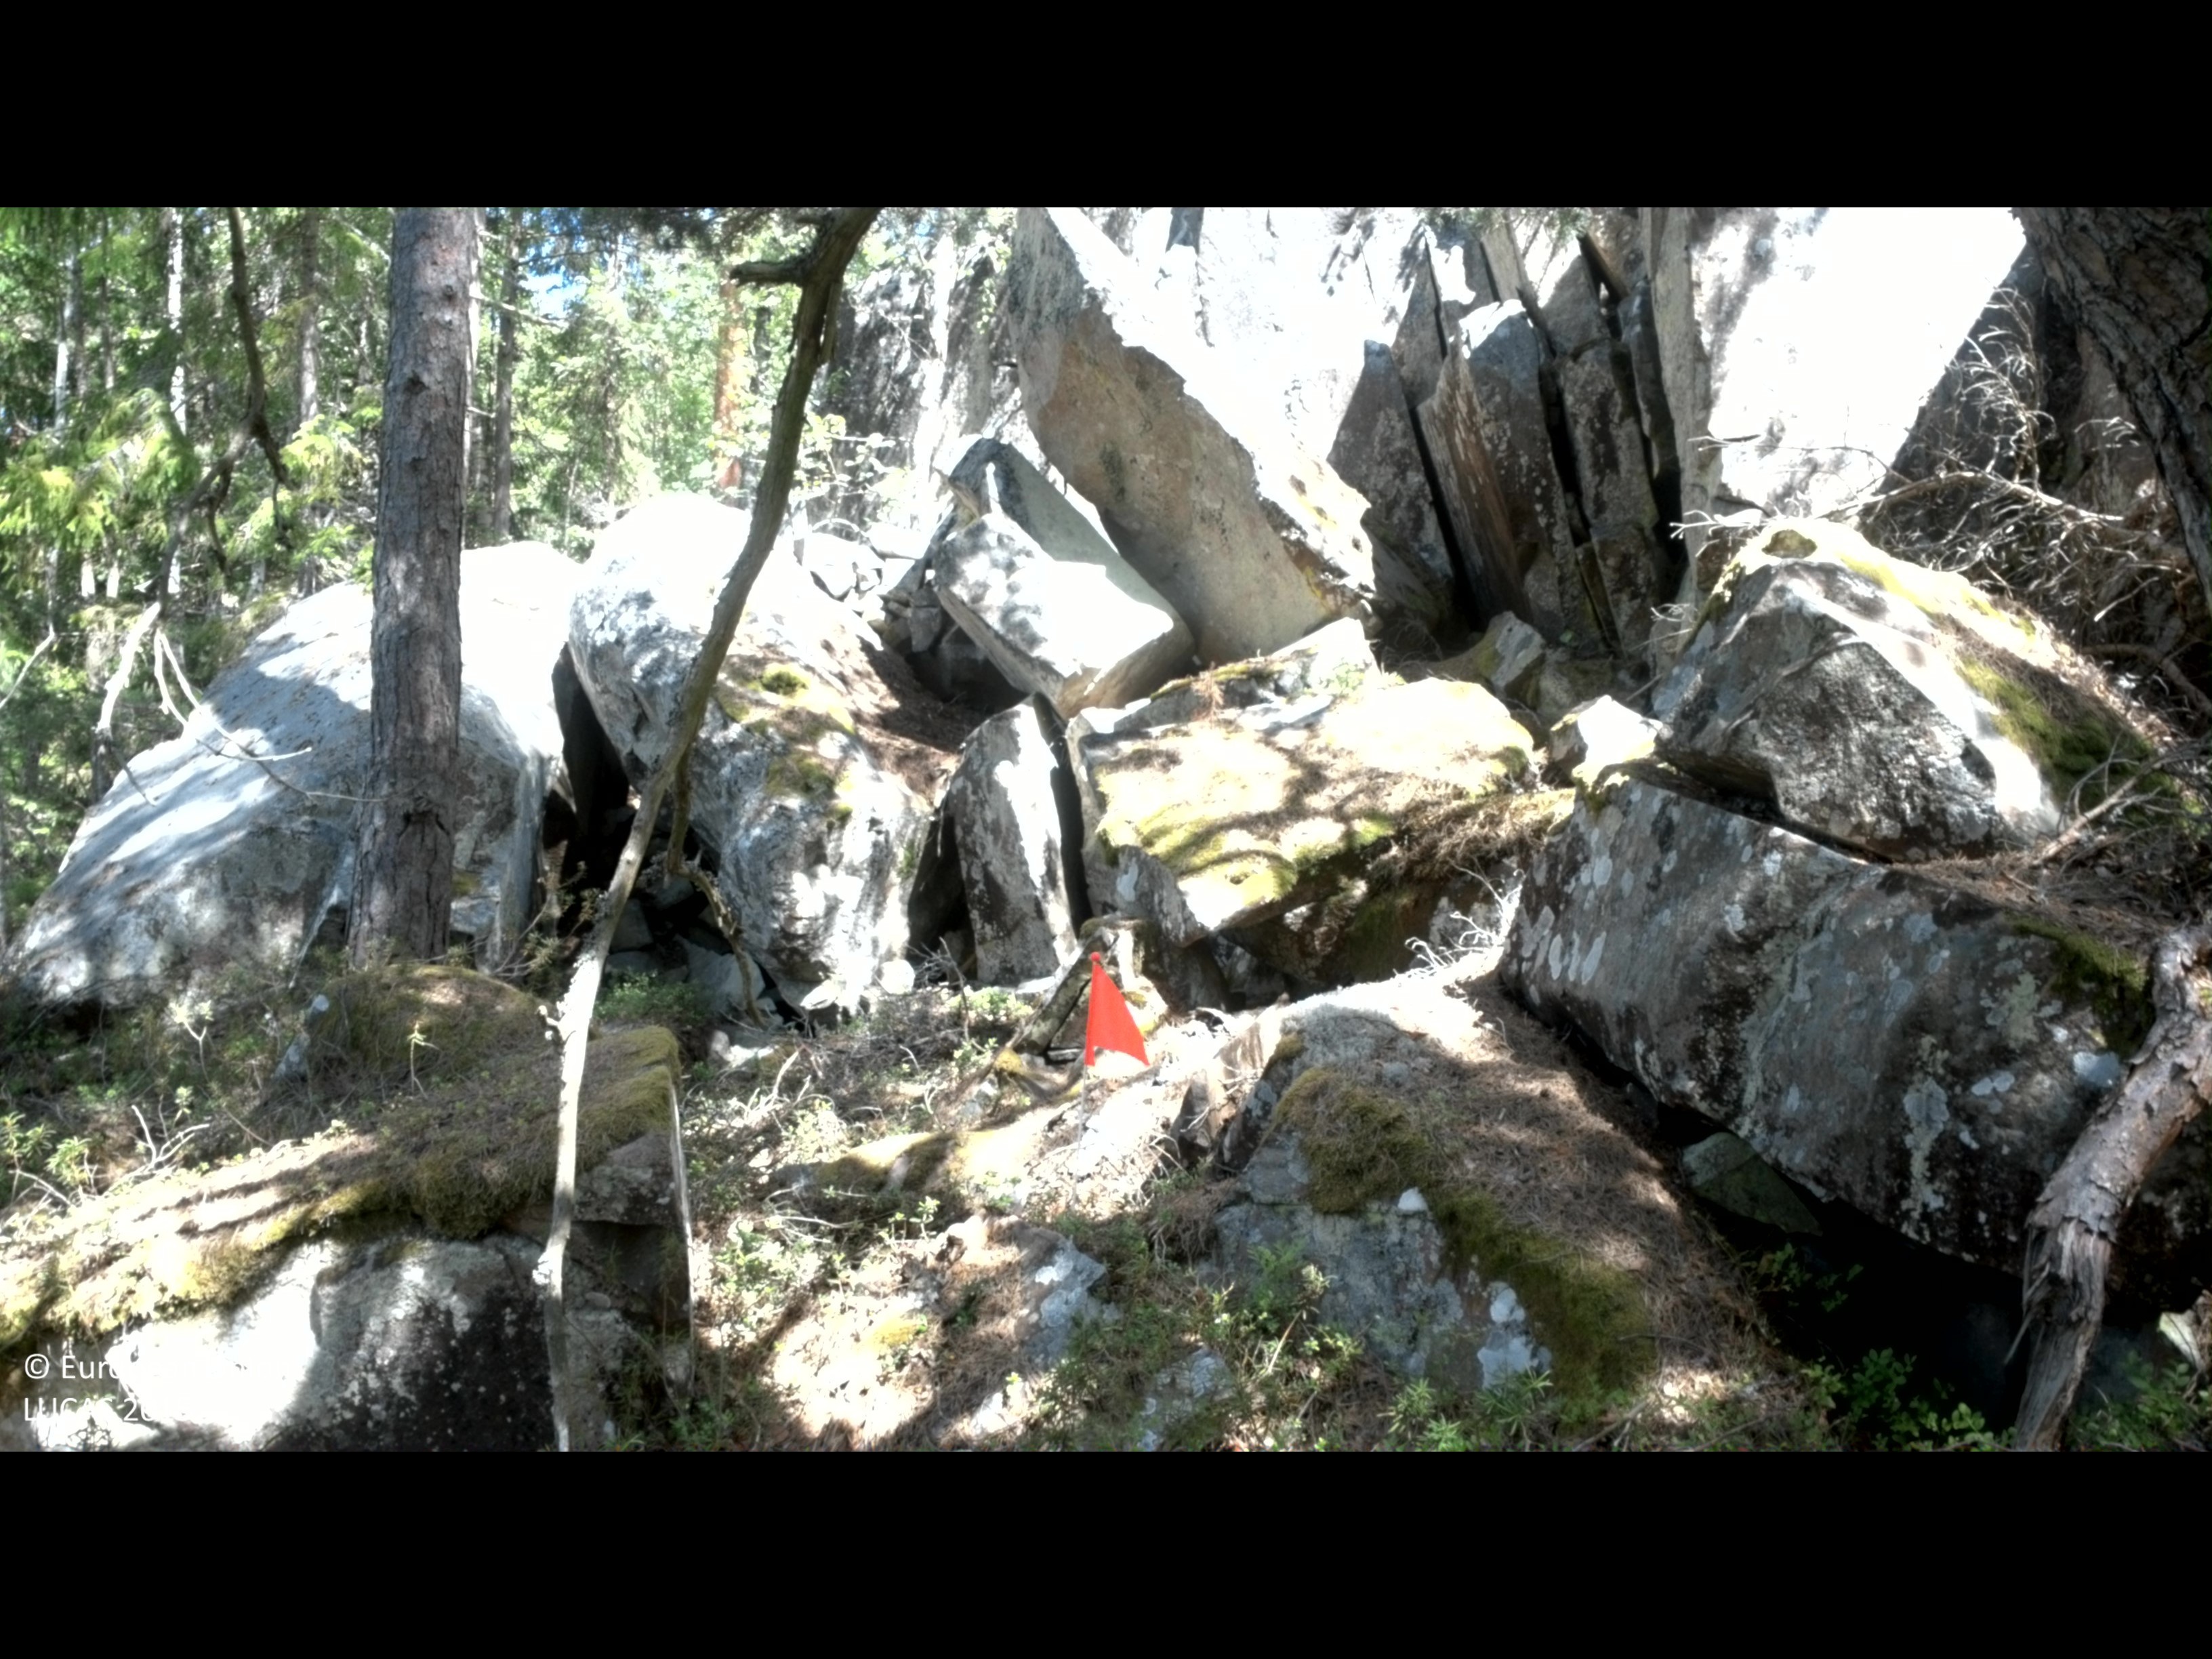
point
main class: Woodland
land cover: Pine dominated coniferous woodland
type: hemiboreal forest and nemoral coniferous forest and mixed broadleaved-coniferous forest
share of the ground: 50 - 75 %
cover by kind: coniferous forest trees 55 %, broadleaved forest trees 15 %, consolidated bare surface 15 %, lichens and mosses 10 %, shrubs 5 %
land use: Forestry
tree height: > 5 m
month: June
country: SE
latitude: 57.6950
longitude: 16.6258
